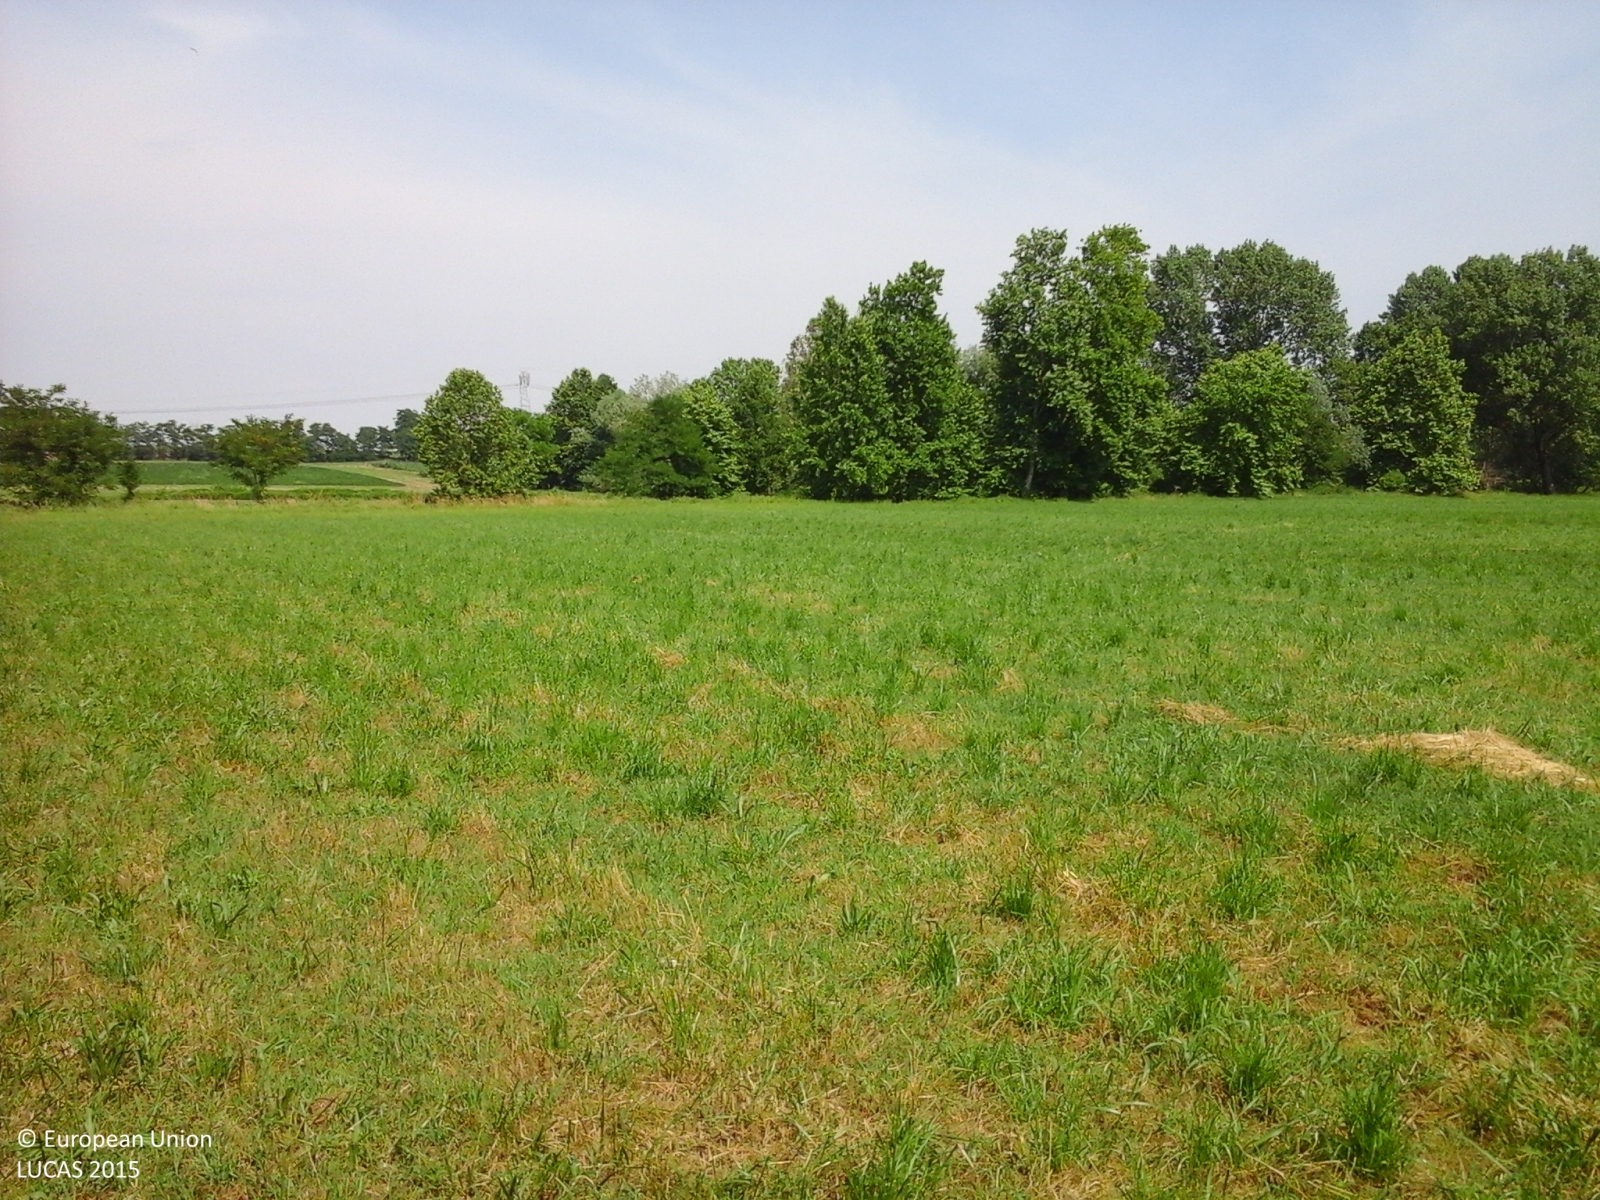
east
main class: Grassland
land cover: Grassland without tree/shrub cover
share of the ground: > 75 %
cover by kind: herbaceous plants 100 %
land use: Agriculture (excluding fallow land and kitchen gardens)
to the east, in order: Grassland without tree/shrub cover; Managed hedges; Inland fresh running water; Managed hedges; Grassland without tree/shrub cover; Grass margins; Ditches and canals; Grass margins; Grassland without tree/shrub cover; Managed hedges; Ditches and canals; Managed hedges; Maize
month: June
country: IT
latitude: 45.1614
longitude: 9.6572
